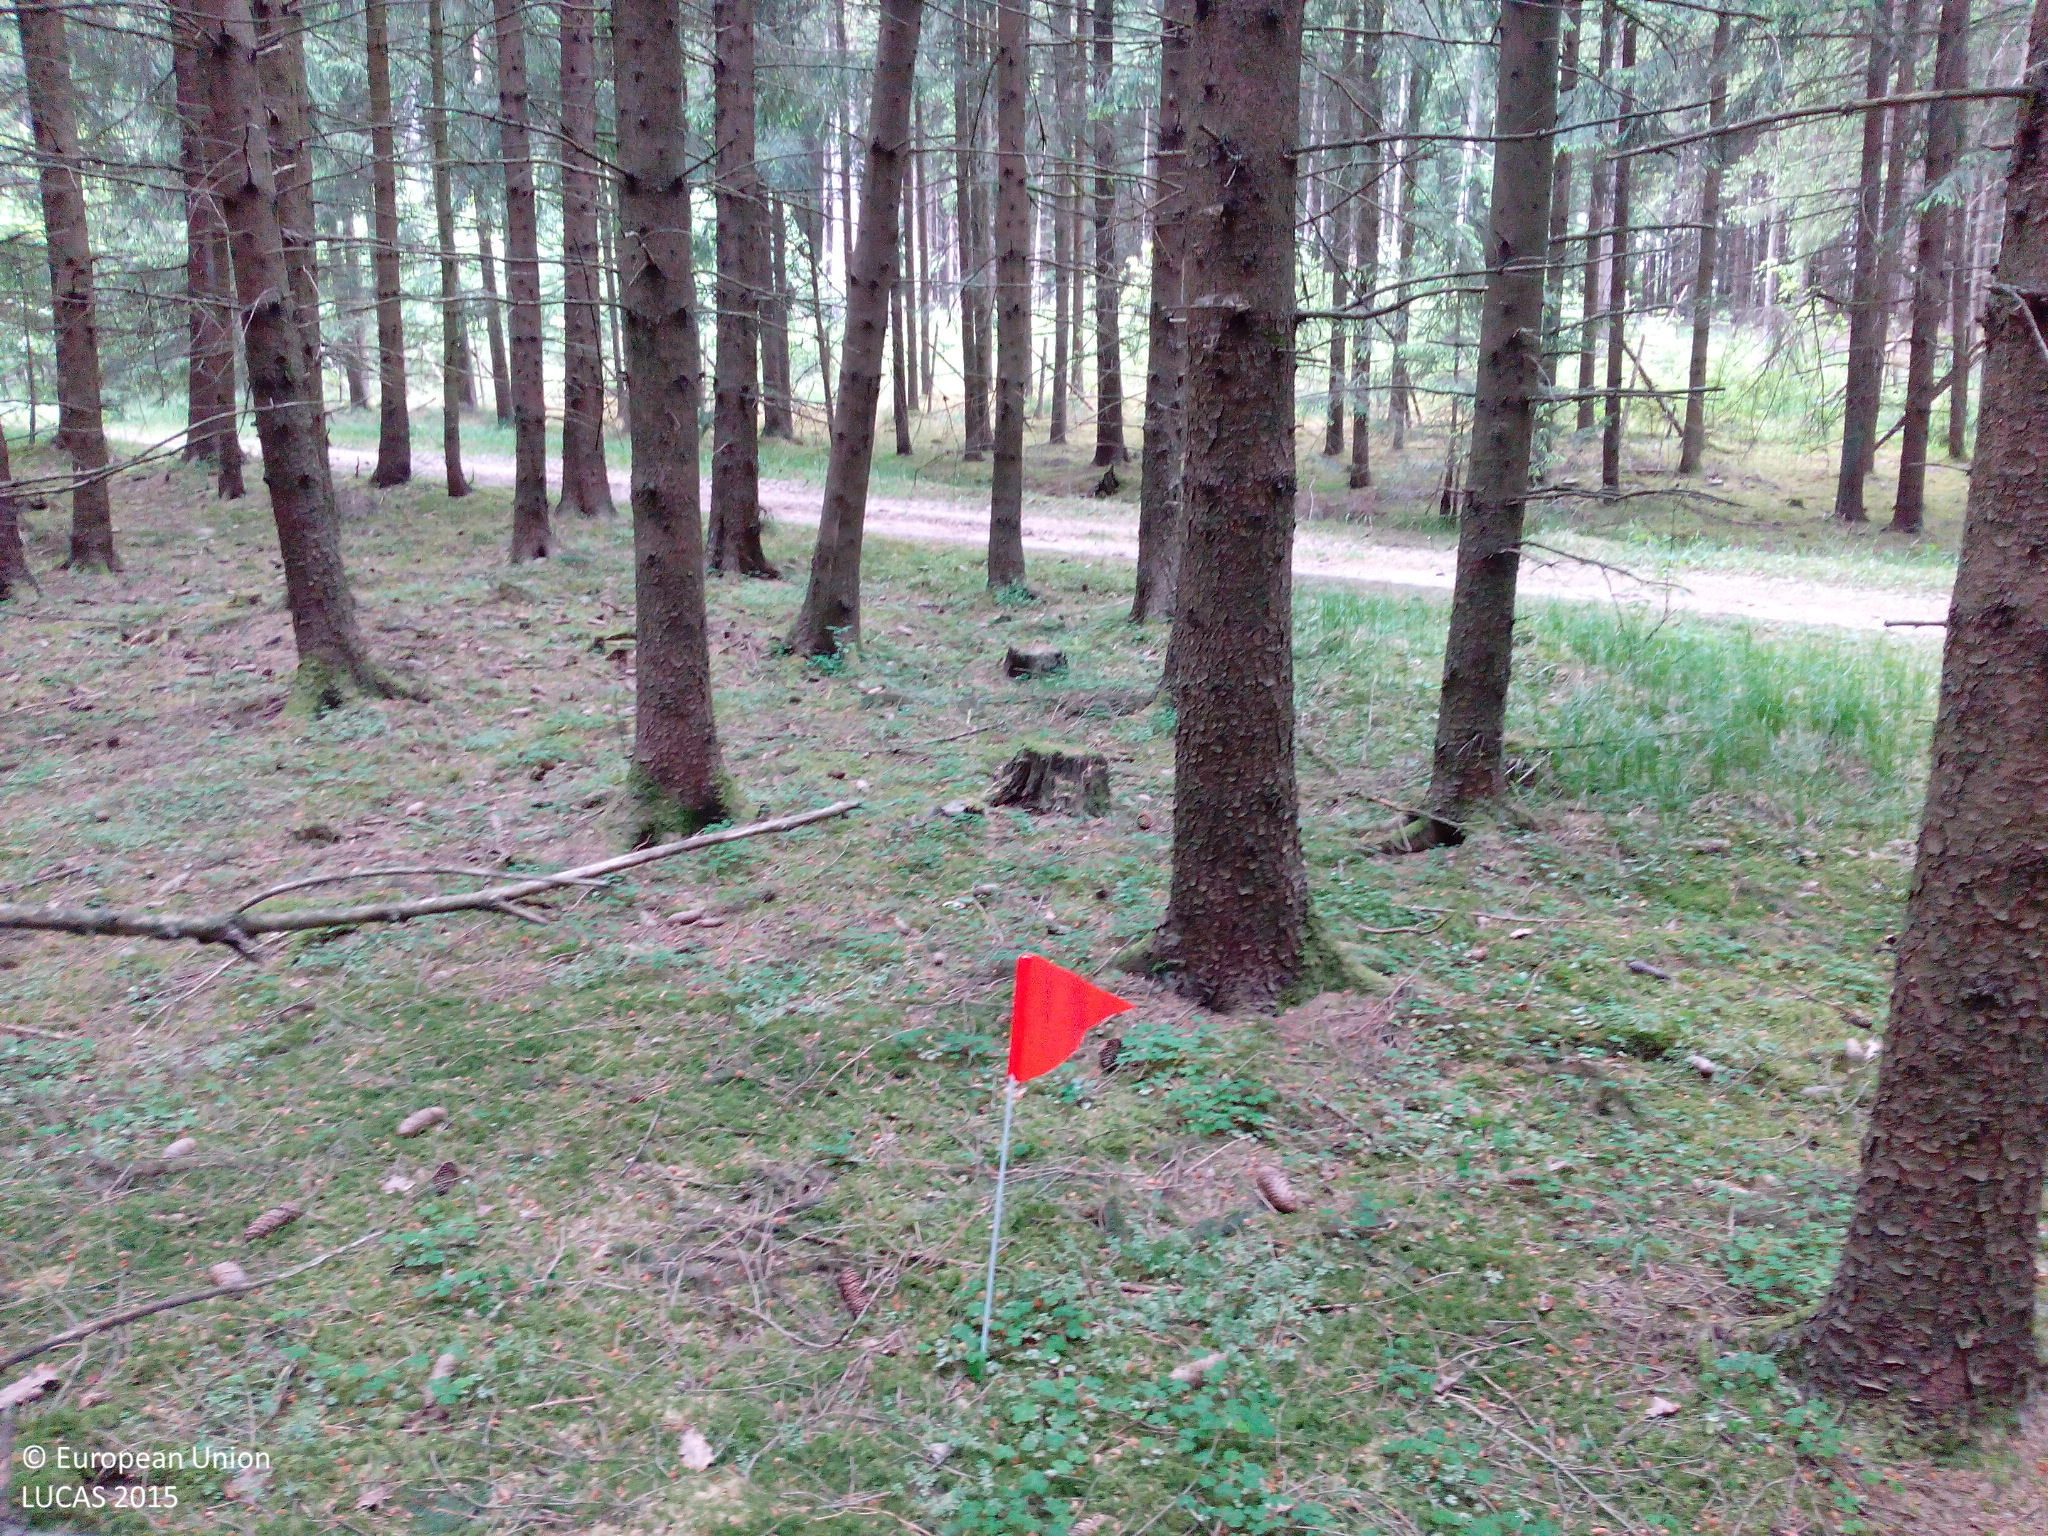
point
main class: Woodland
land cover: Spruce dominated coniferous woodland
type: hemiboreal forest and nemoral coniferous forest and mixed broadleaved-coniferous forest
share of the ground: > 75 %
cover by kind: coniferous forest trees 80 %, herbaceous plants 20 %
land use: Forestry
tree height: > 5 m
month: May
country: DE
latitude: 49.1408
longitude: 10.2603
